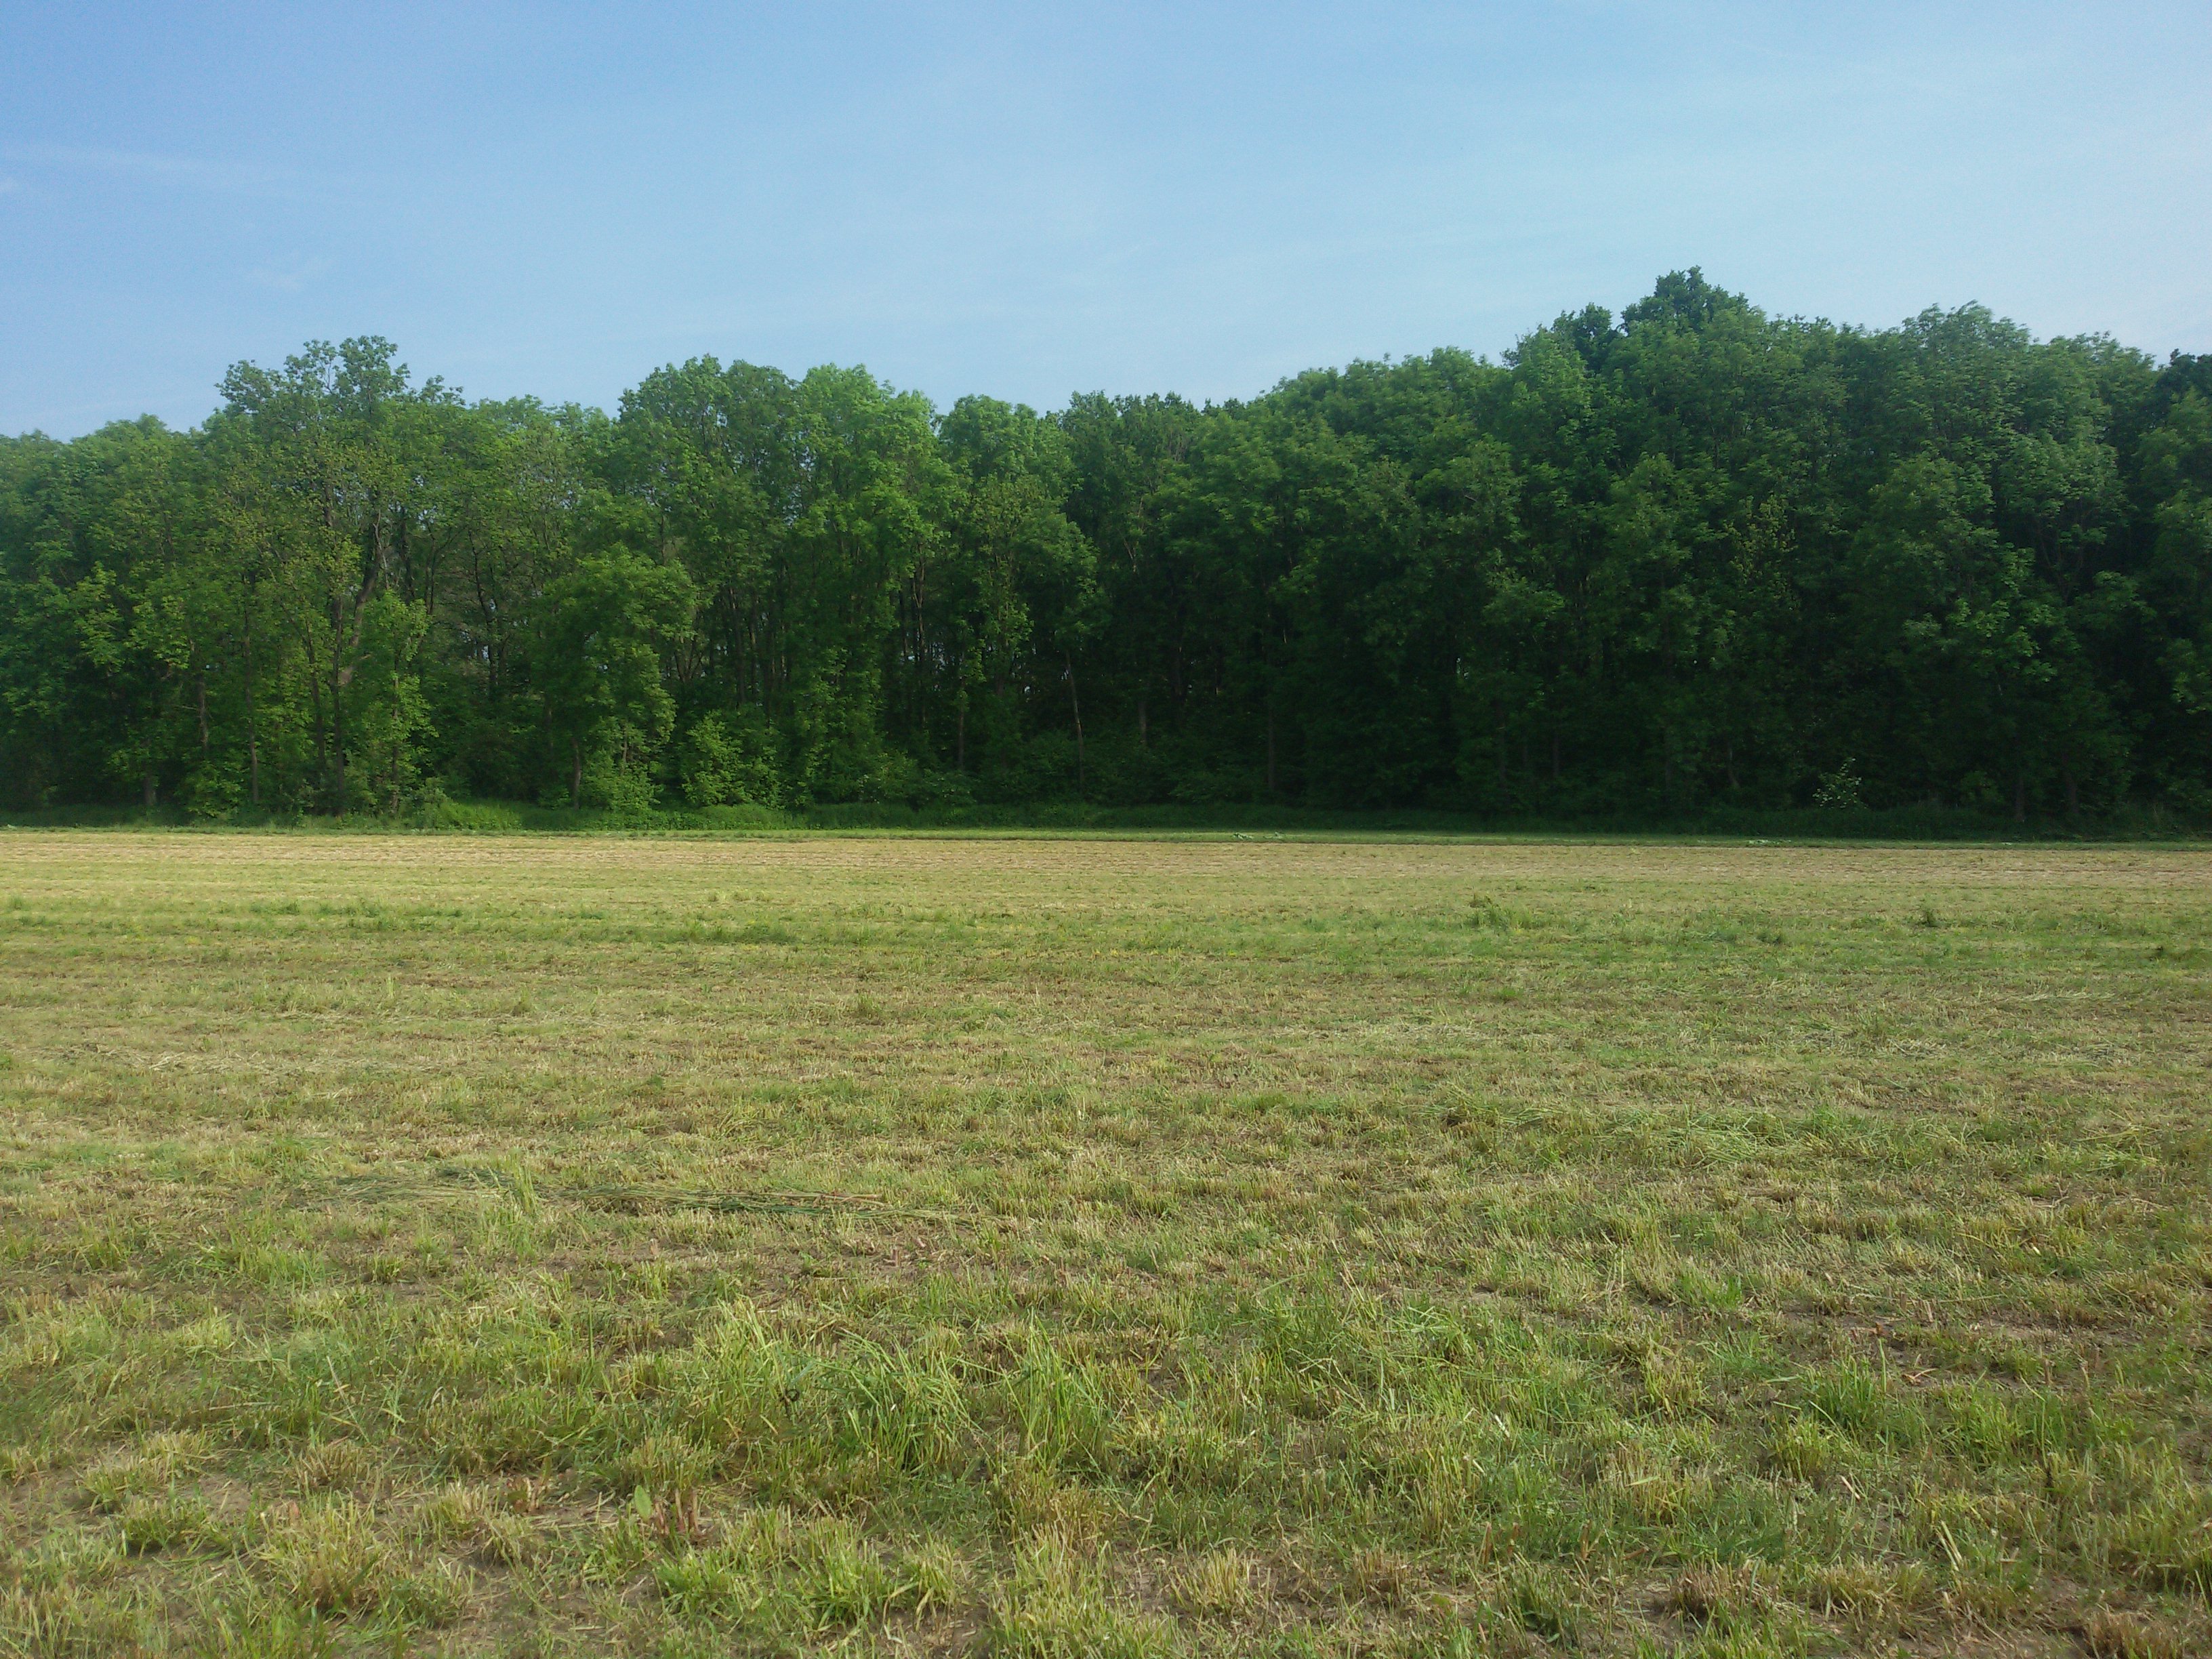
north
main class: Cropland
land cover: Temporary grasslands
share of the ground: > 75 %
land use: Agriculture (excluding fallow land and kitchen gardens)
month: May
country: PL
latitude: 50.4989
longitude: 17.1868
